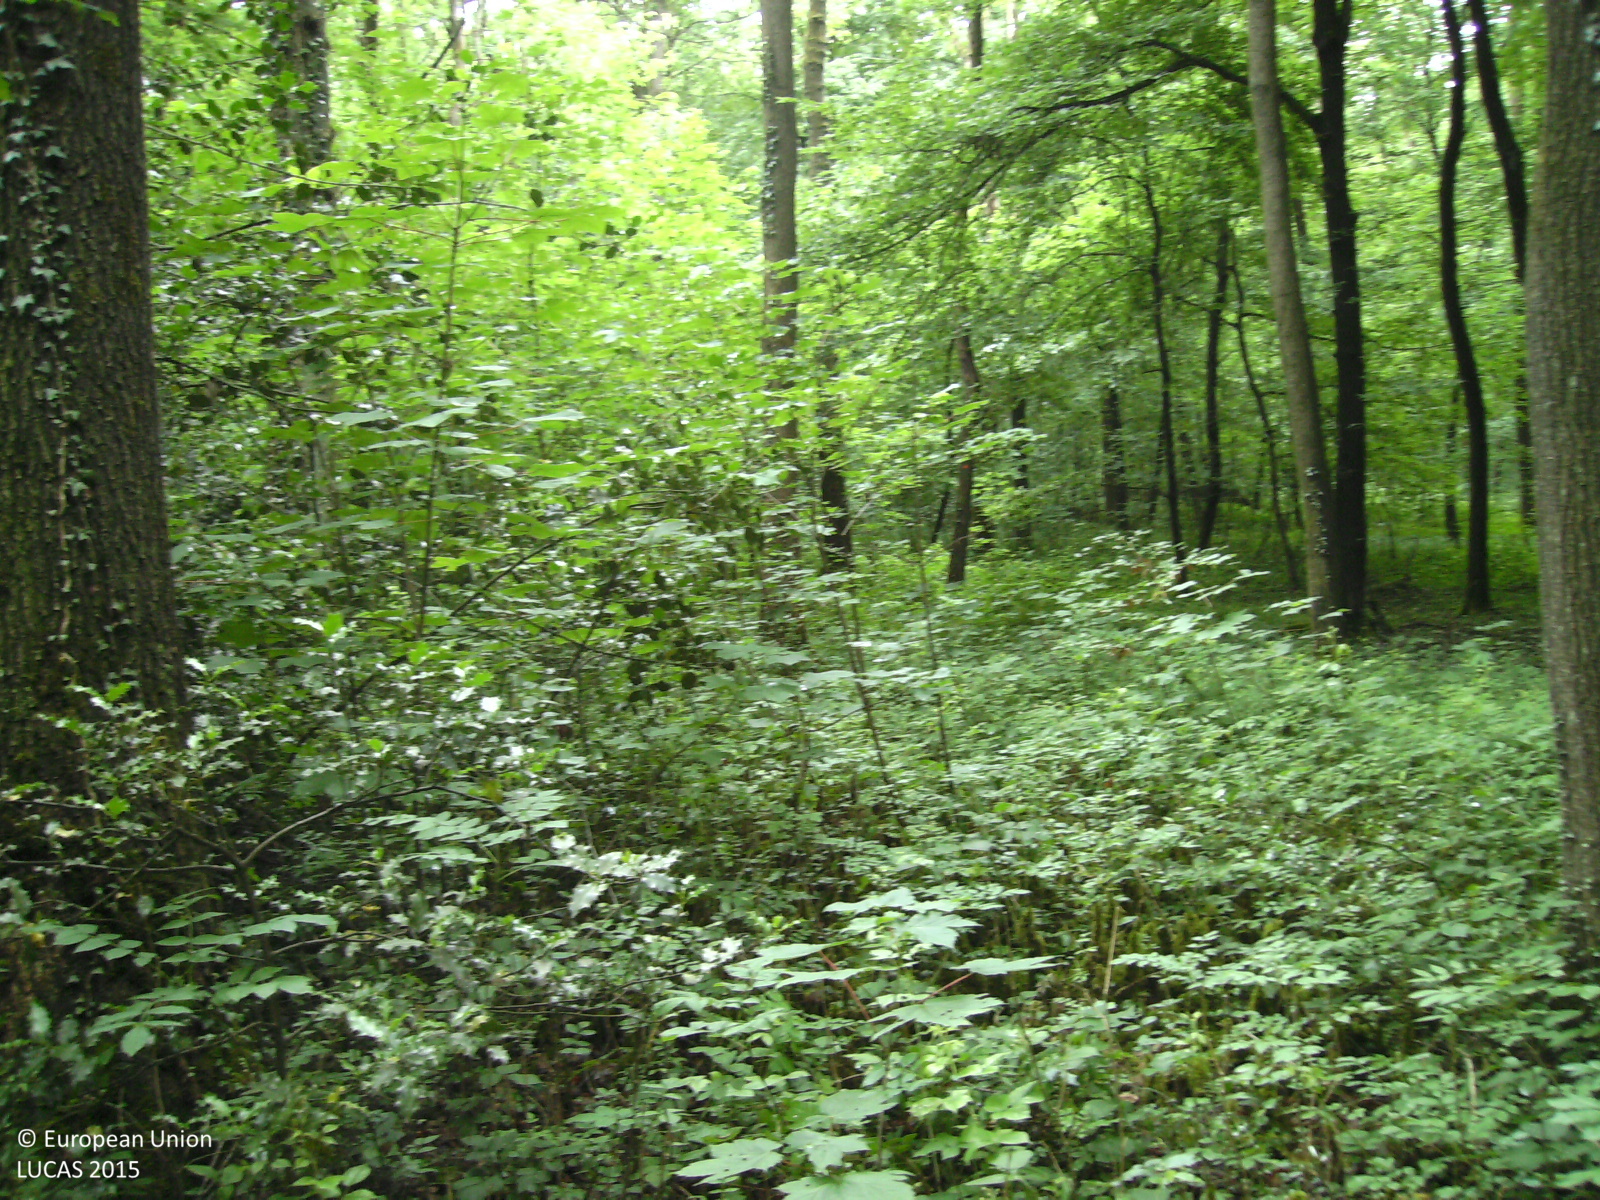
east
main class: Woodland
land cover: Broadleaved woodland
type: mesophytic deciduous forest
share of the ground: > 75 %
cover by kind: broadleaved forest trees 100 %
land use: Forestry
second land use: Amenities, museums, leisure
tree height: > 5 m
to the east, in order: Broadleaved woodland; Spruce dominated coniferous woodland; Spruce dominated mixed woodland; Tracks; Broadleaved woodland; Spruce dominated mixed woodland; Broadleaved woodland
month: June
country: DE
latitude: 51.2253
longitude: 7.0359
